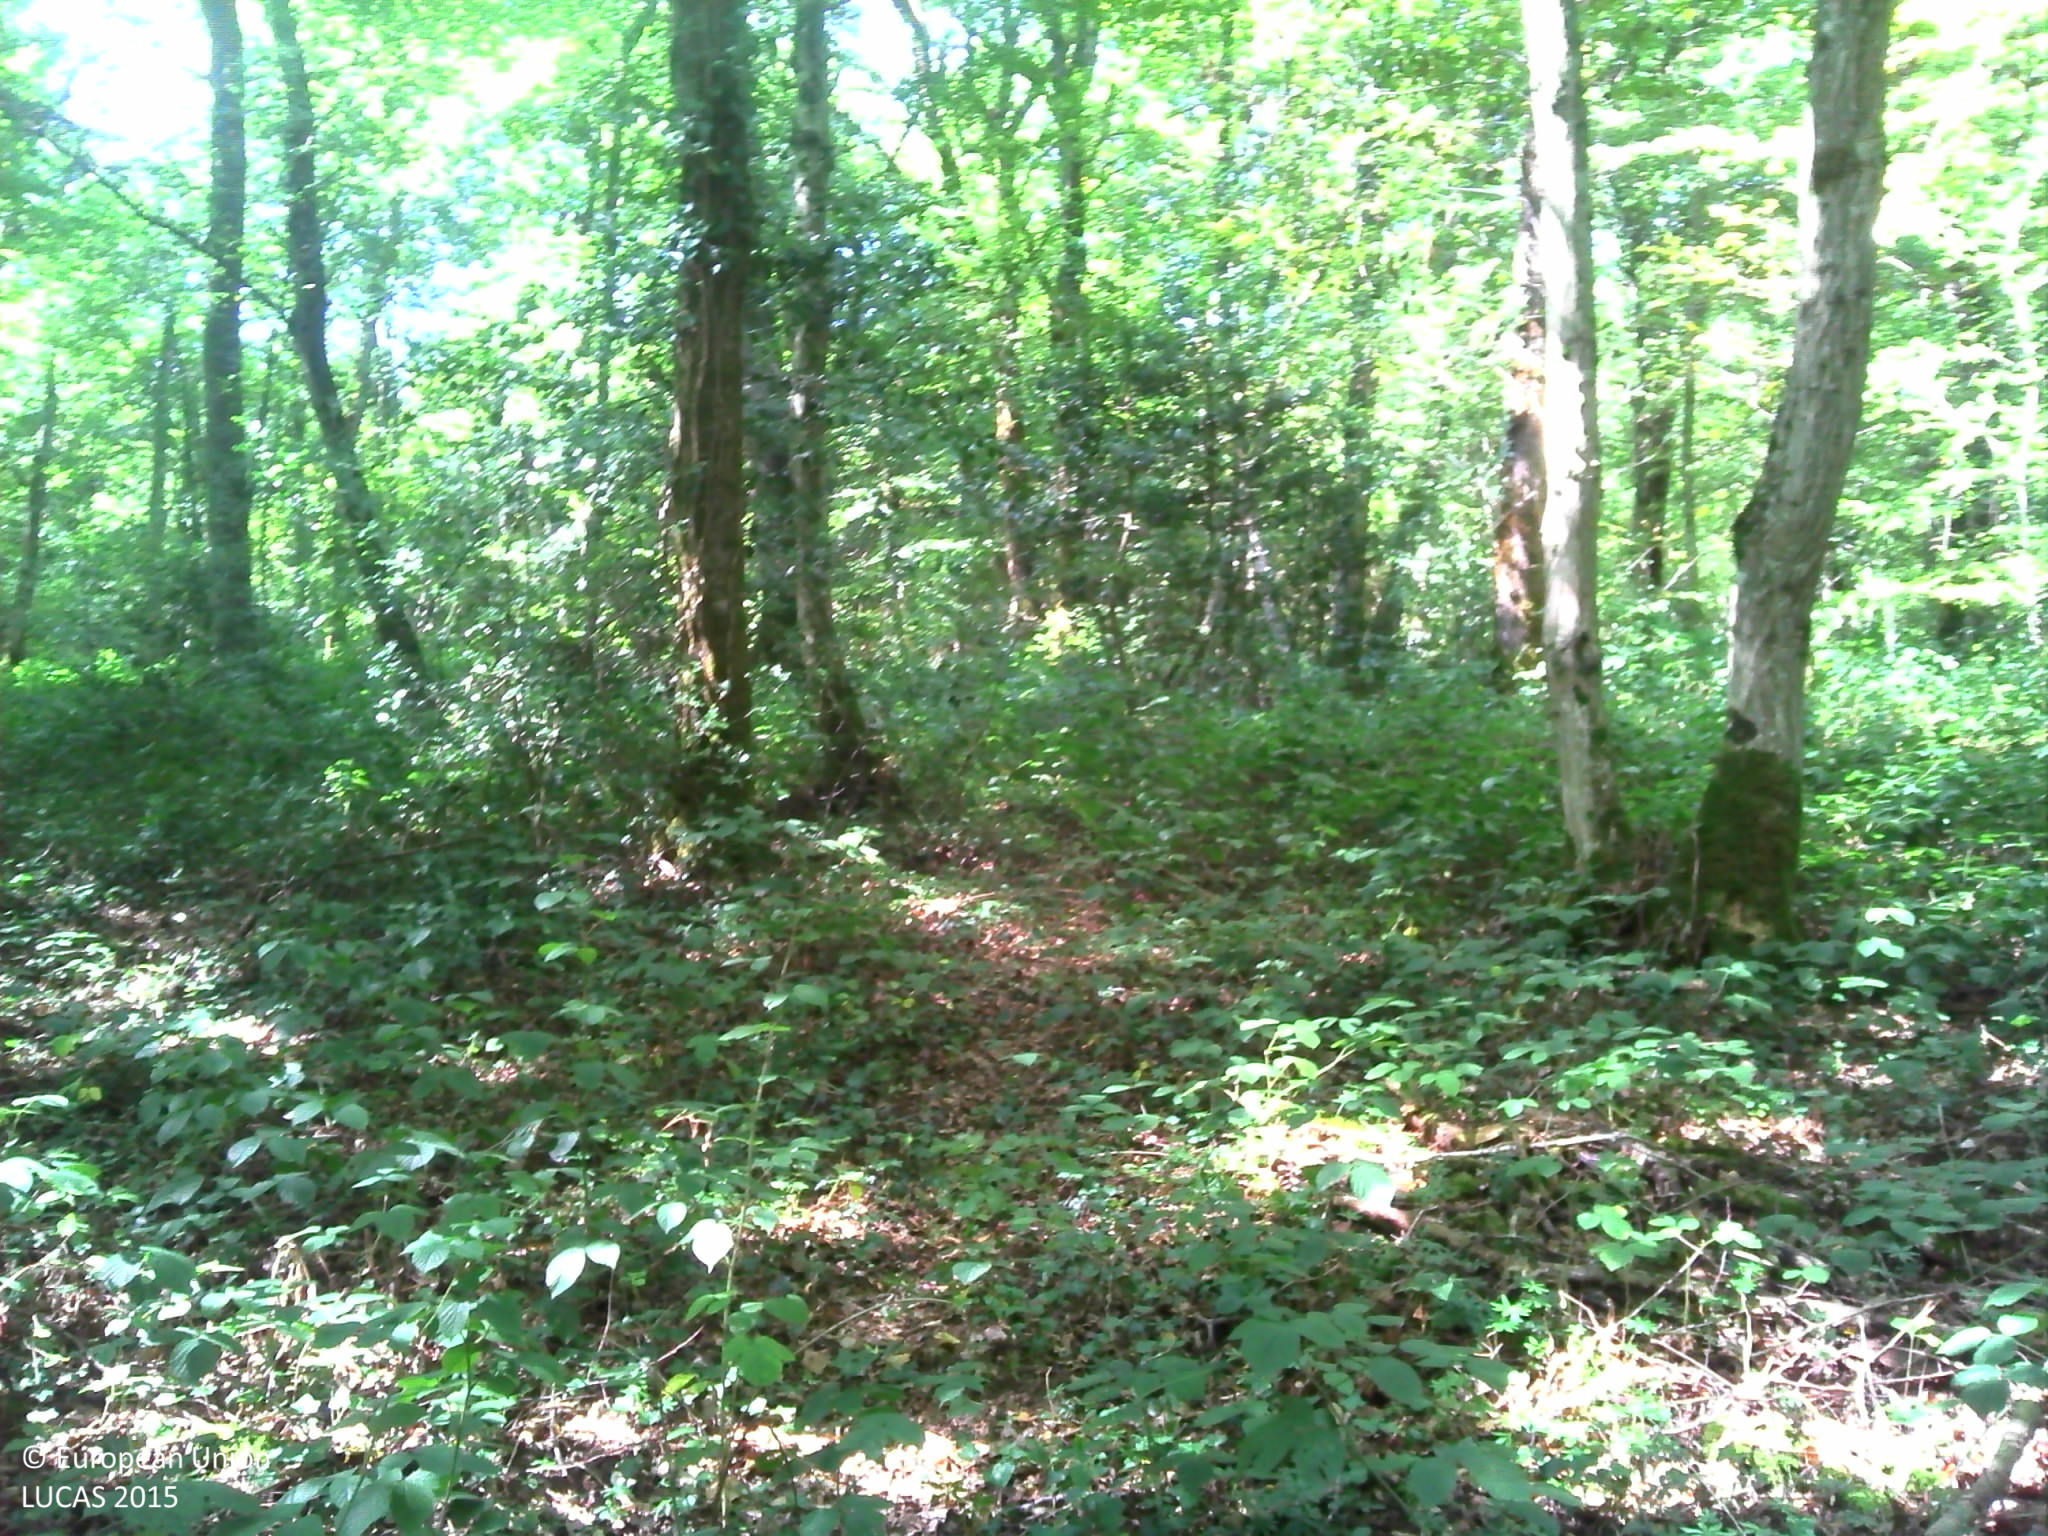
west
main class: Woodland
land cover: Broadleaved woodland
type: mesophytic deciduous forest
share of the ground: > 75 %
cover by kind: broadleaved forest trees 100 %
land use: Forestry
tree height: > 5 m
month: September
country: FR
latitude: 47.4049
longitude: 6.3045
